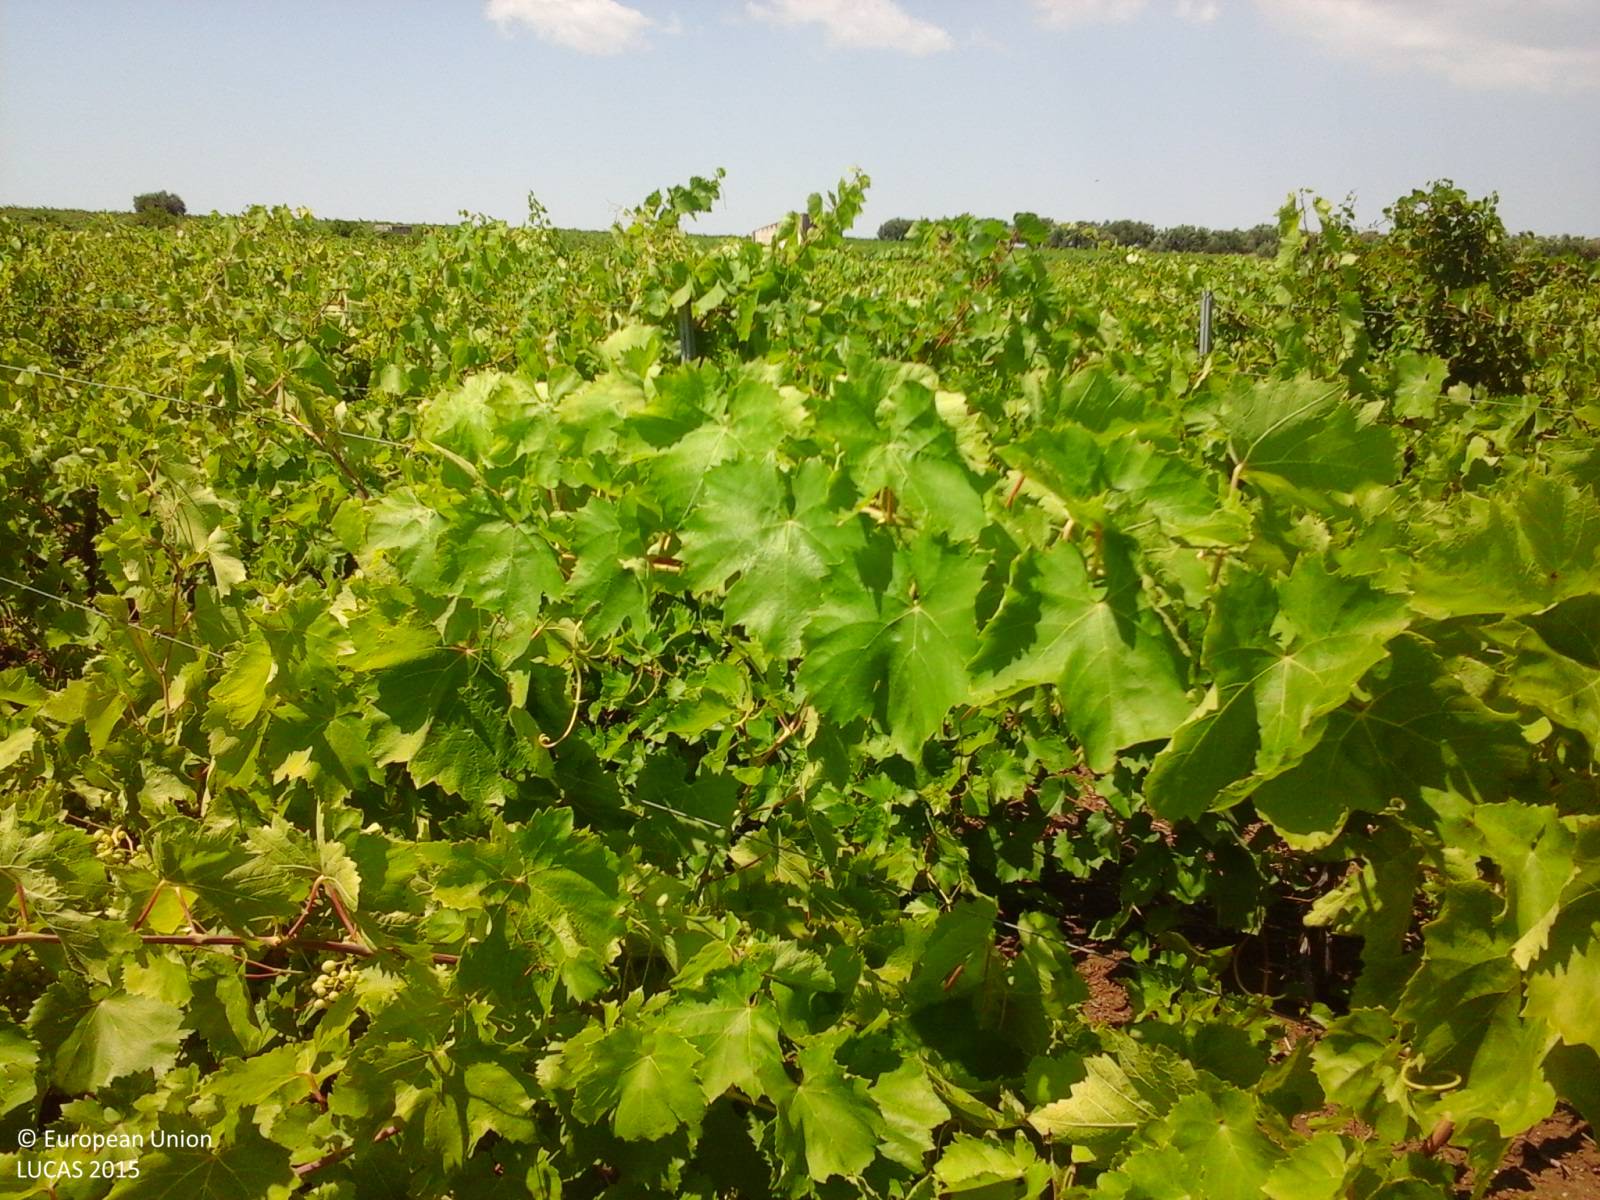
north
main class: Cropland
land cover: Vineyards
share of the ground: 50 - 75 %
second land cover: Other bare soil
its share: > 75 %
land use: Agriculture (excluding fallow land and kitchen gardens)
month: July
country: IT
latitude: 37.7289
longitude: 12.6464
